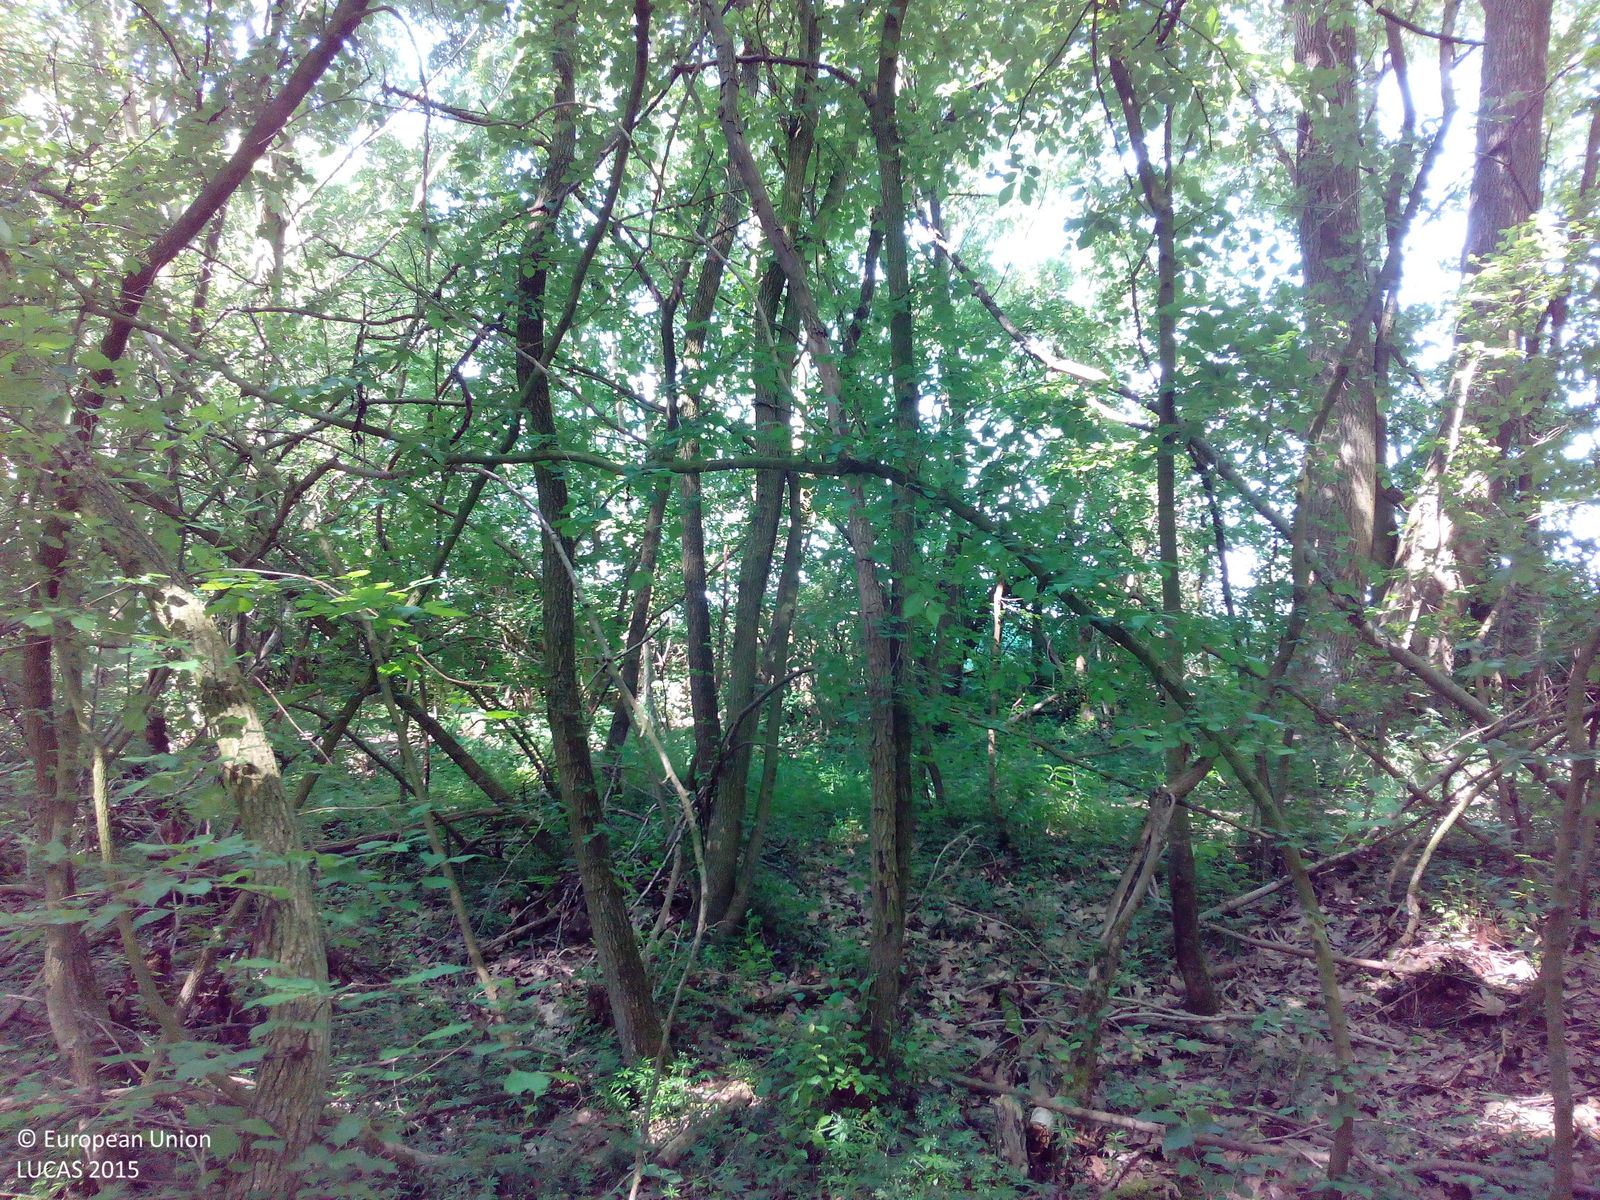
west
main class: Woodland
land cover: Spruce dominated mixed woodland
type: hemiboreal forest and nemoral coniferous forest and mixed broadleaved-coniferous forest
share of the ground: > 75 %
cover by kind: broadleaved forest trees 65 %, coniferous forest trees 25 %, herbaceous plants 10 %
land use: Community services
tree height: > 5 m
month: June
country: DE
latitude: 51.8381
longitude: 9.8694
